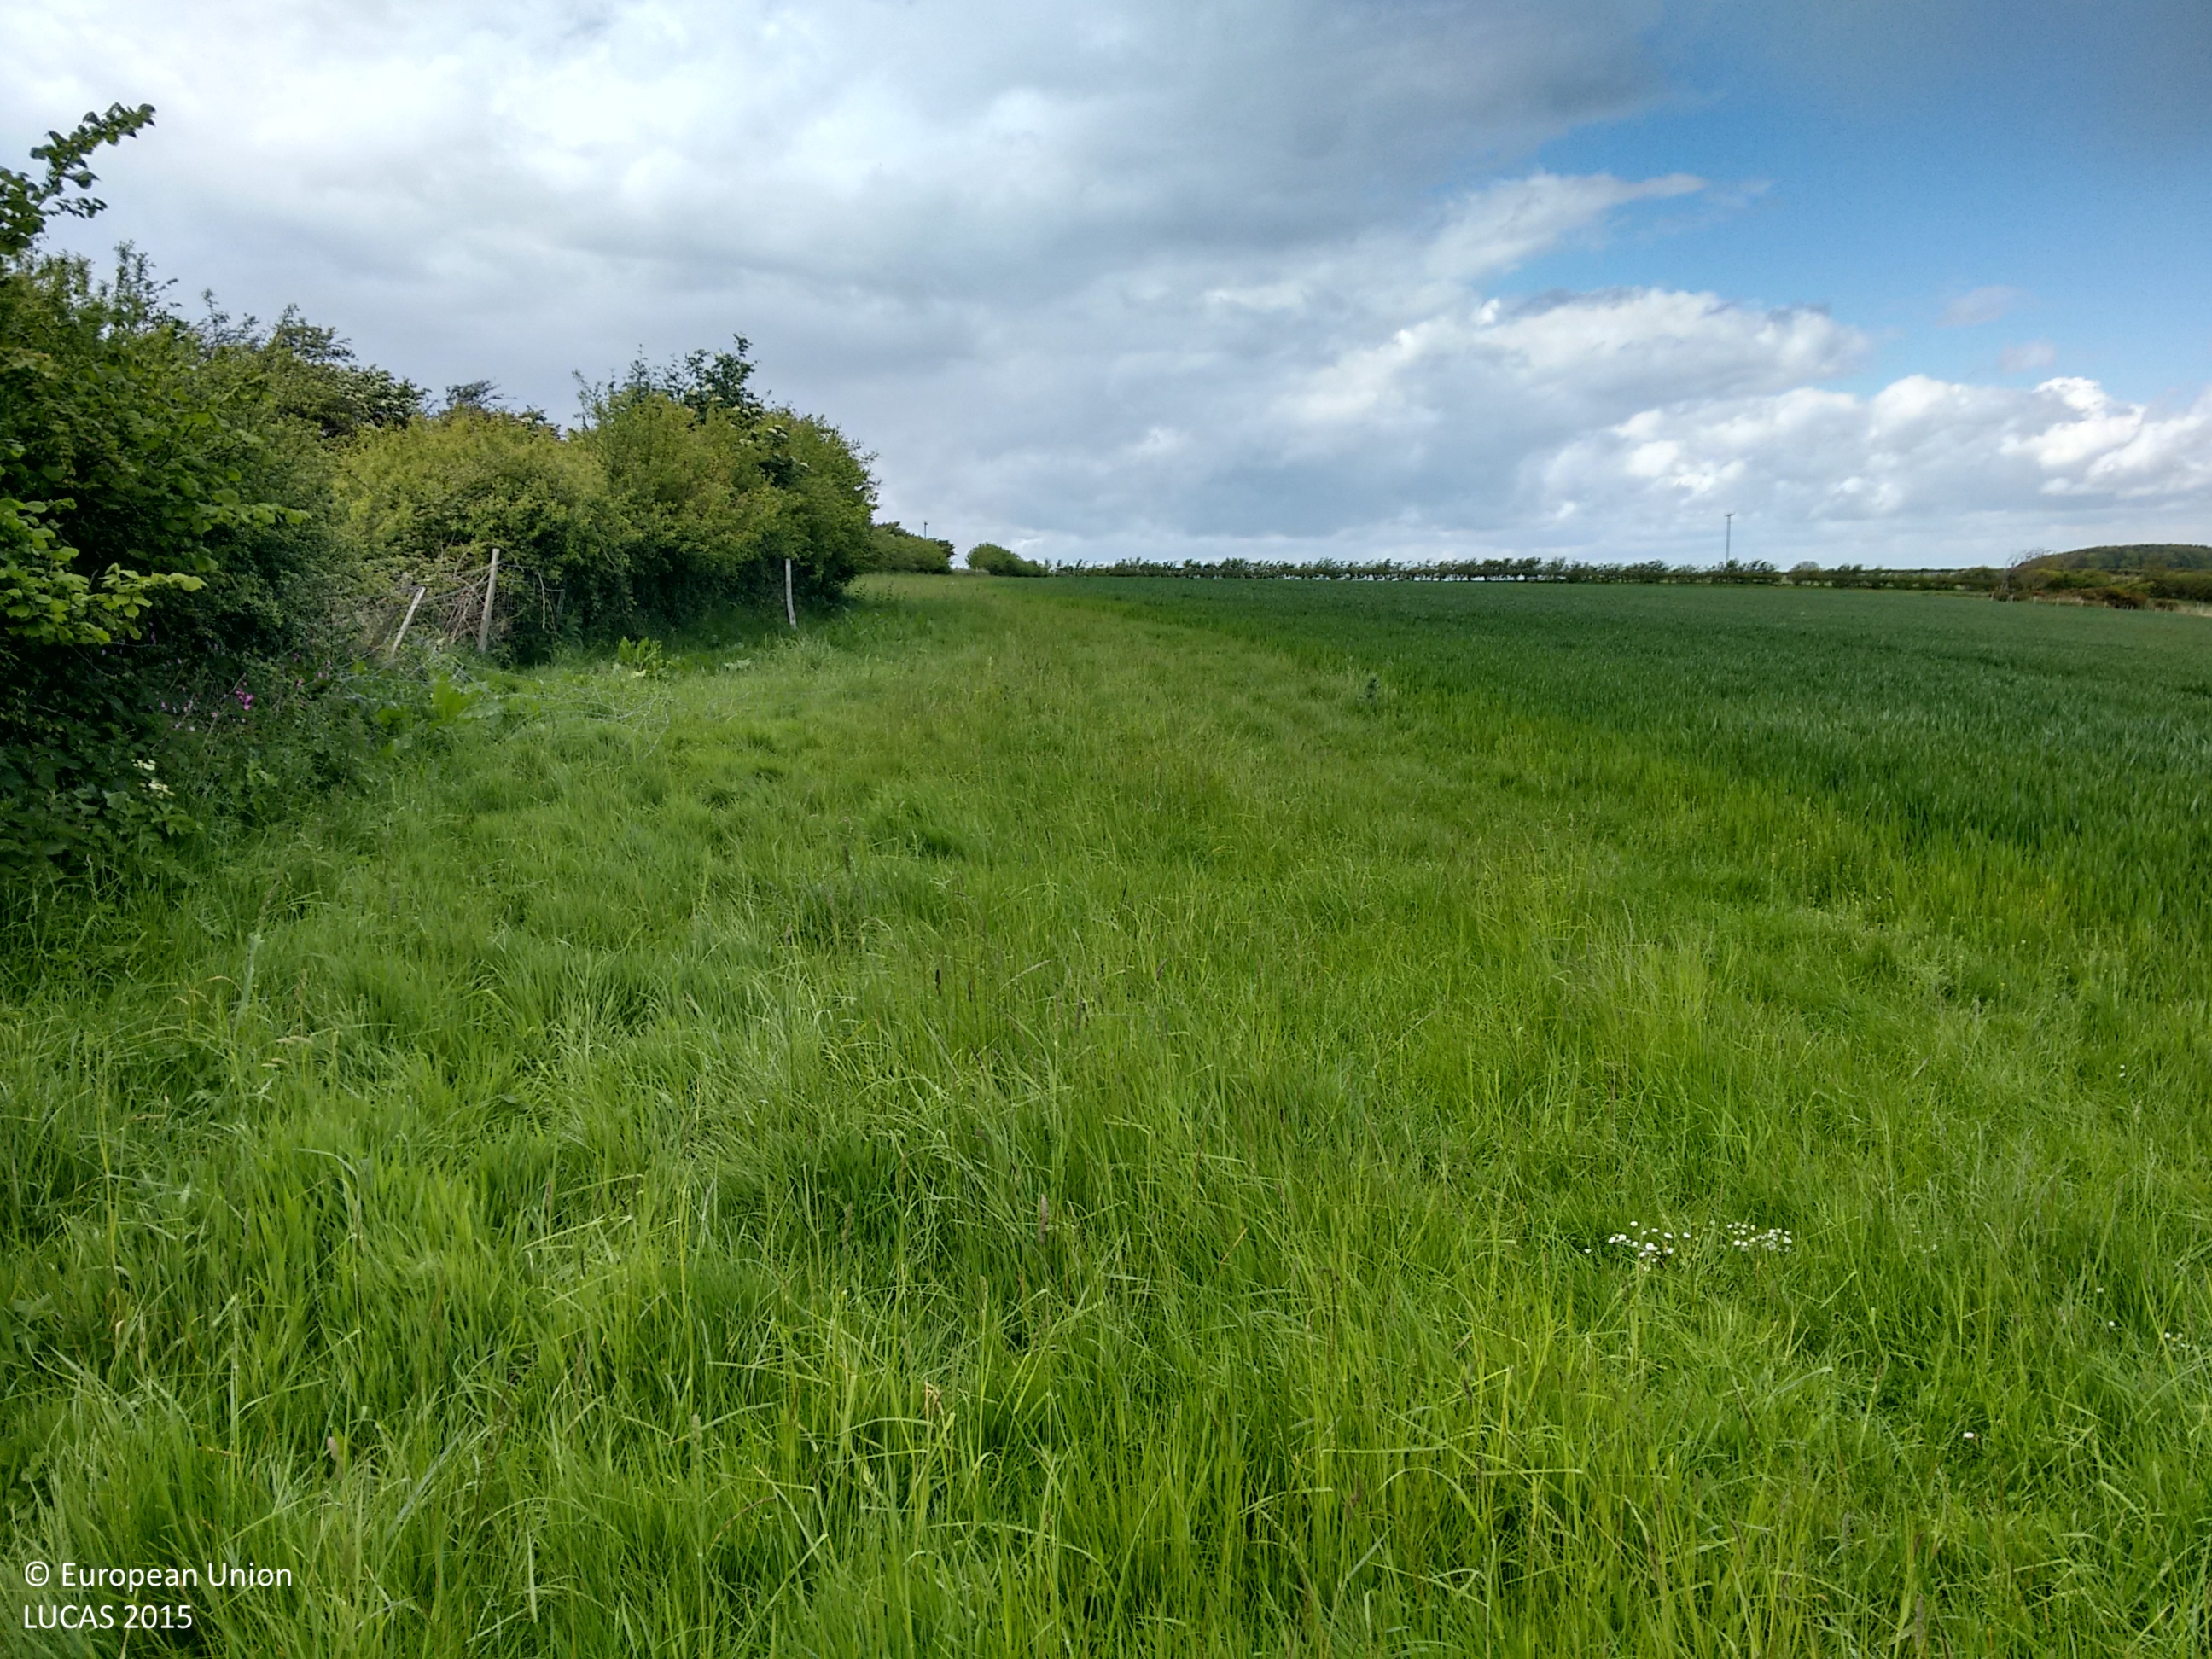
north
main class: Grassland
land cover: Grassland without tree/shrub cover
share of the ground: > 75 %
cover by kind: herbaceous plants 100 %
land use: Agriculture (excluding fallow land and kitchen gardens)
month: May
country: GB
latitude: 50.6684
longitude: -1.3537
